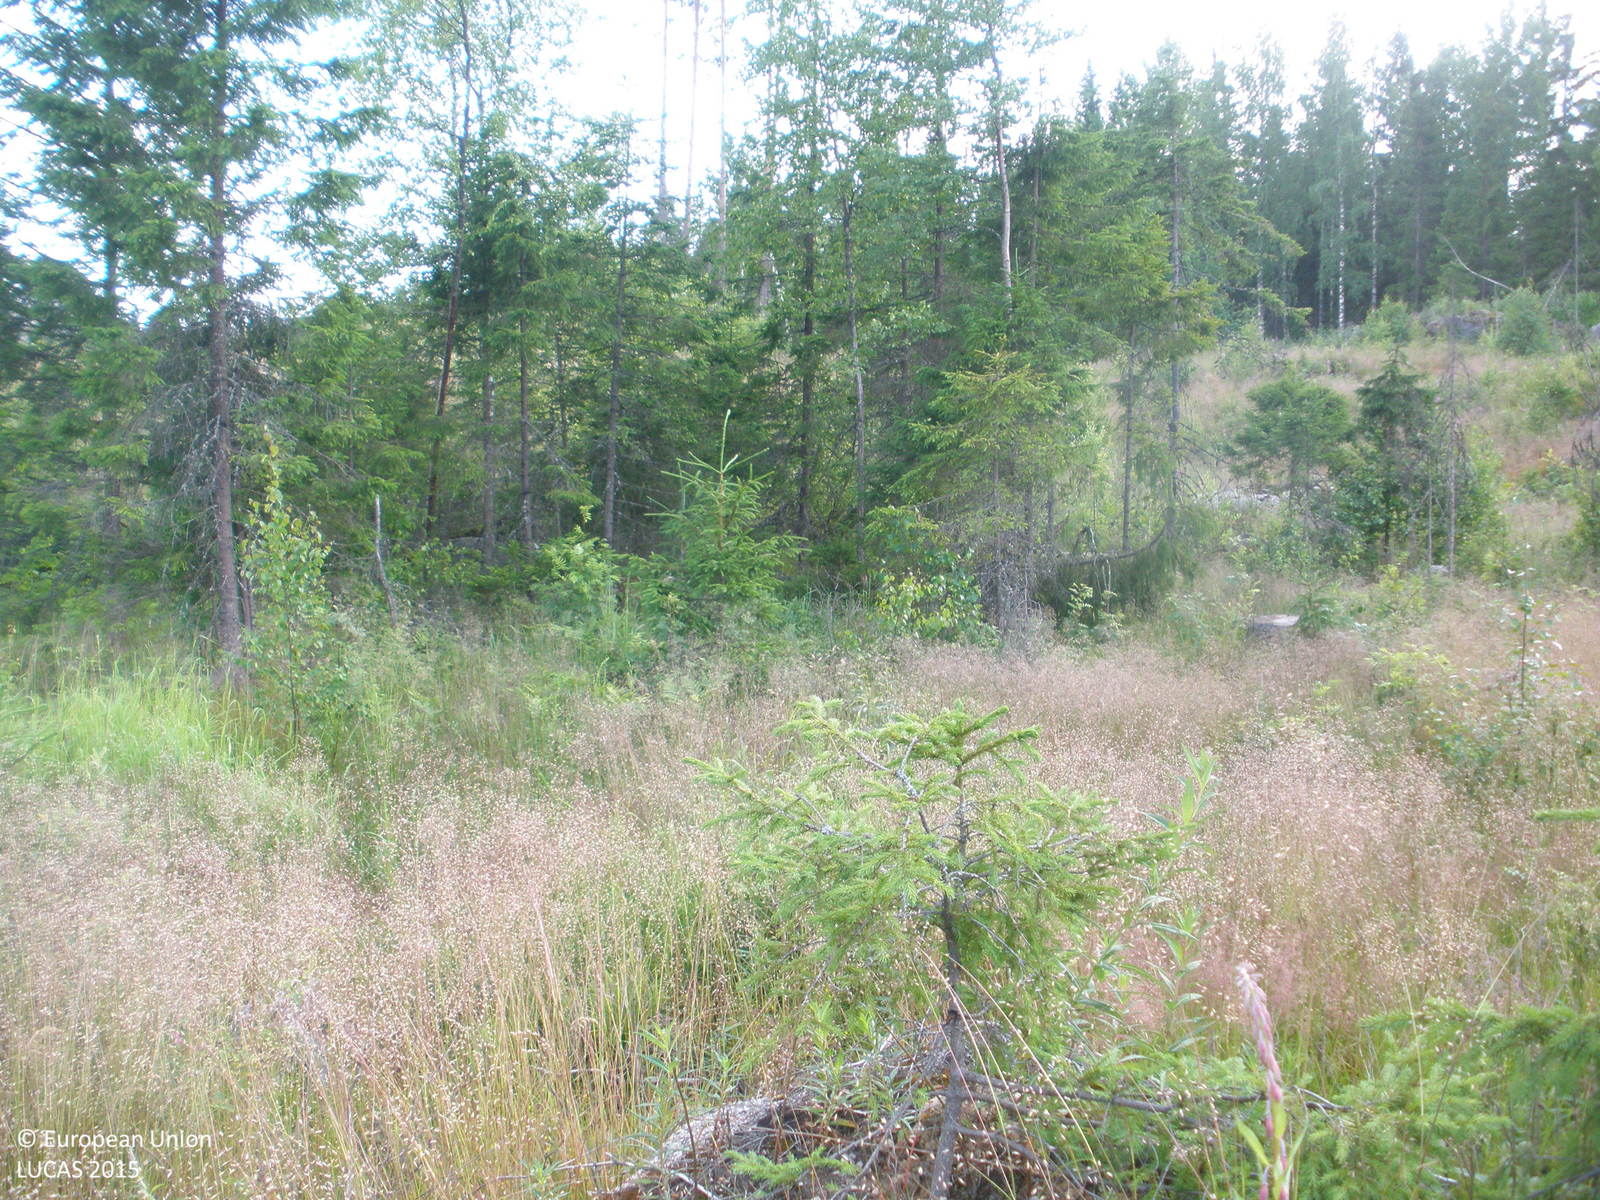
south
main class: Grassland
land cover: Grassland with sparse tree/shrub cover
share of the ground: > 75 %
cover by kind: herbaceous plants 90 %, coniferous forest trees 5 %, shrubs 5 %
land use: Forestry
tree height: < 5 m
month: July
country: FI
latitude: 61.3886
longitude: 23.9601
